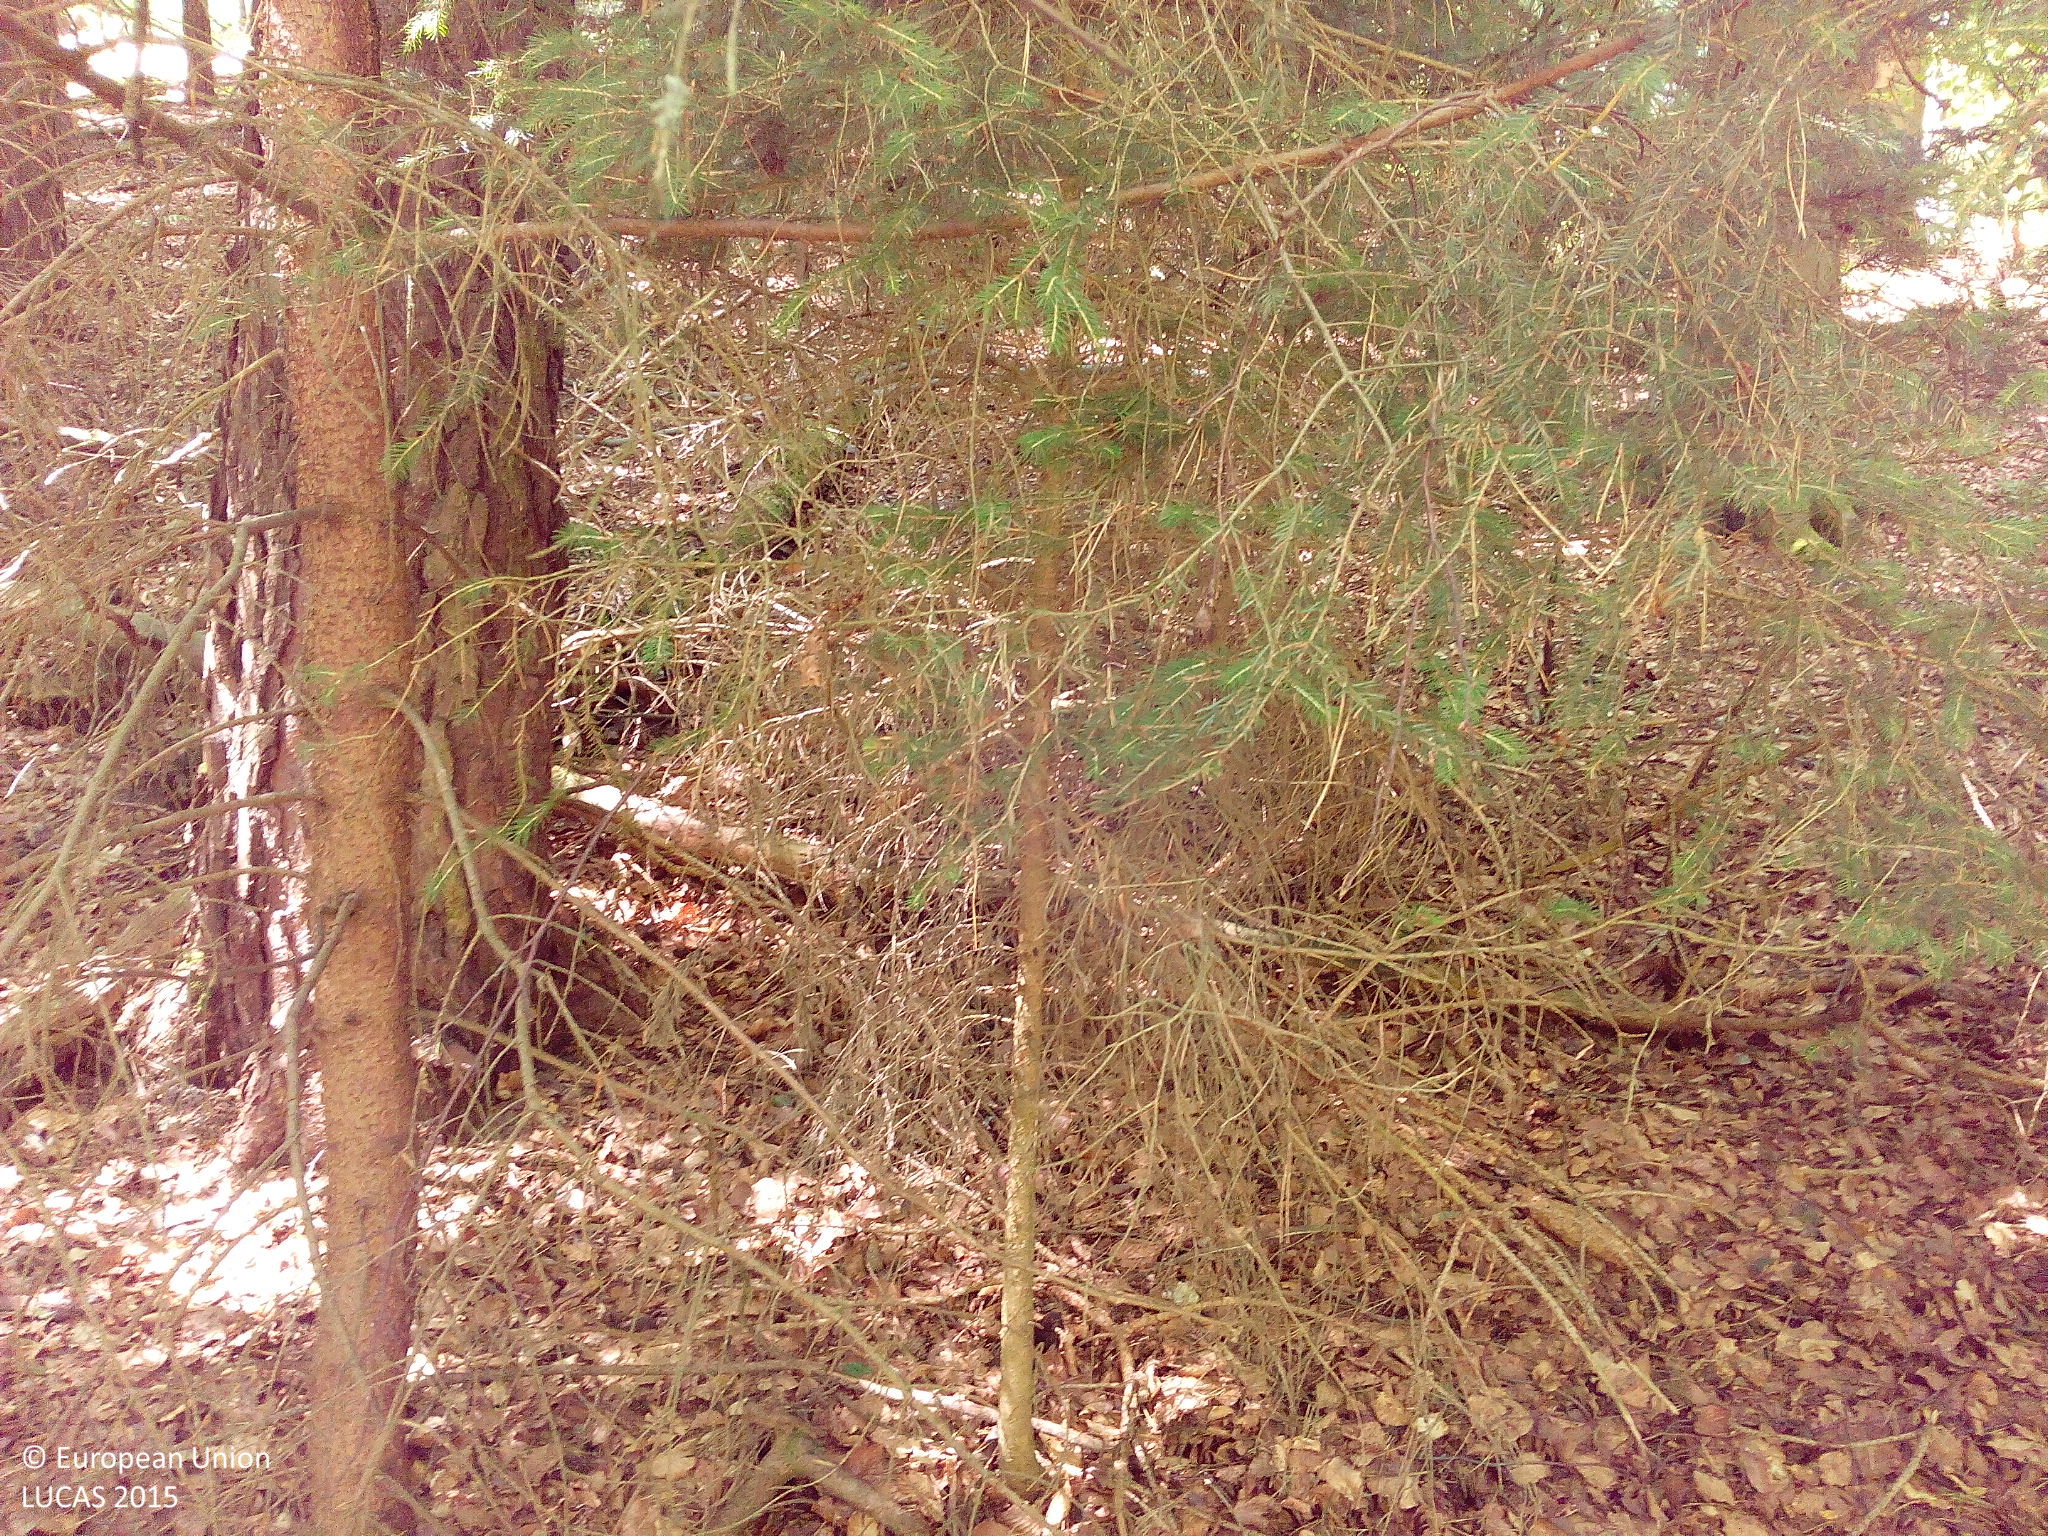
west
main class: Woodland
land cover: Pine dominated mixed woodland
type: hemiboreal forest and nemoral coniferous forest and mixed broadleaved-coniferous forest
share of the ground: > 75 %
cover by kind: coniferous forest trees 50 %, broadleaved forest trees 50 %
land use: Forestry
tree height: > 5 m
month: July
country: DE
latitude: 50.9214
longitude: 9.9573
